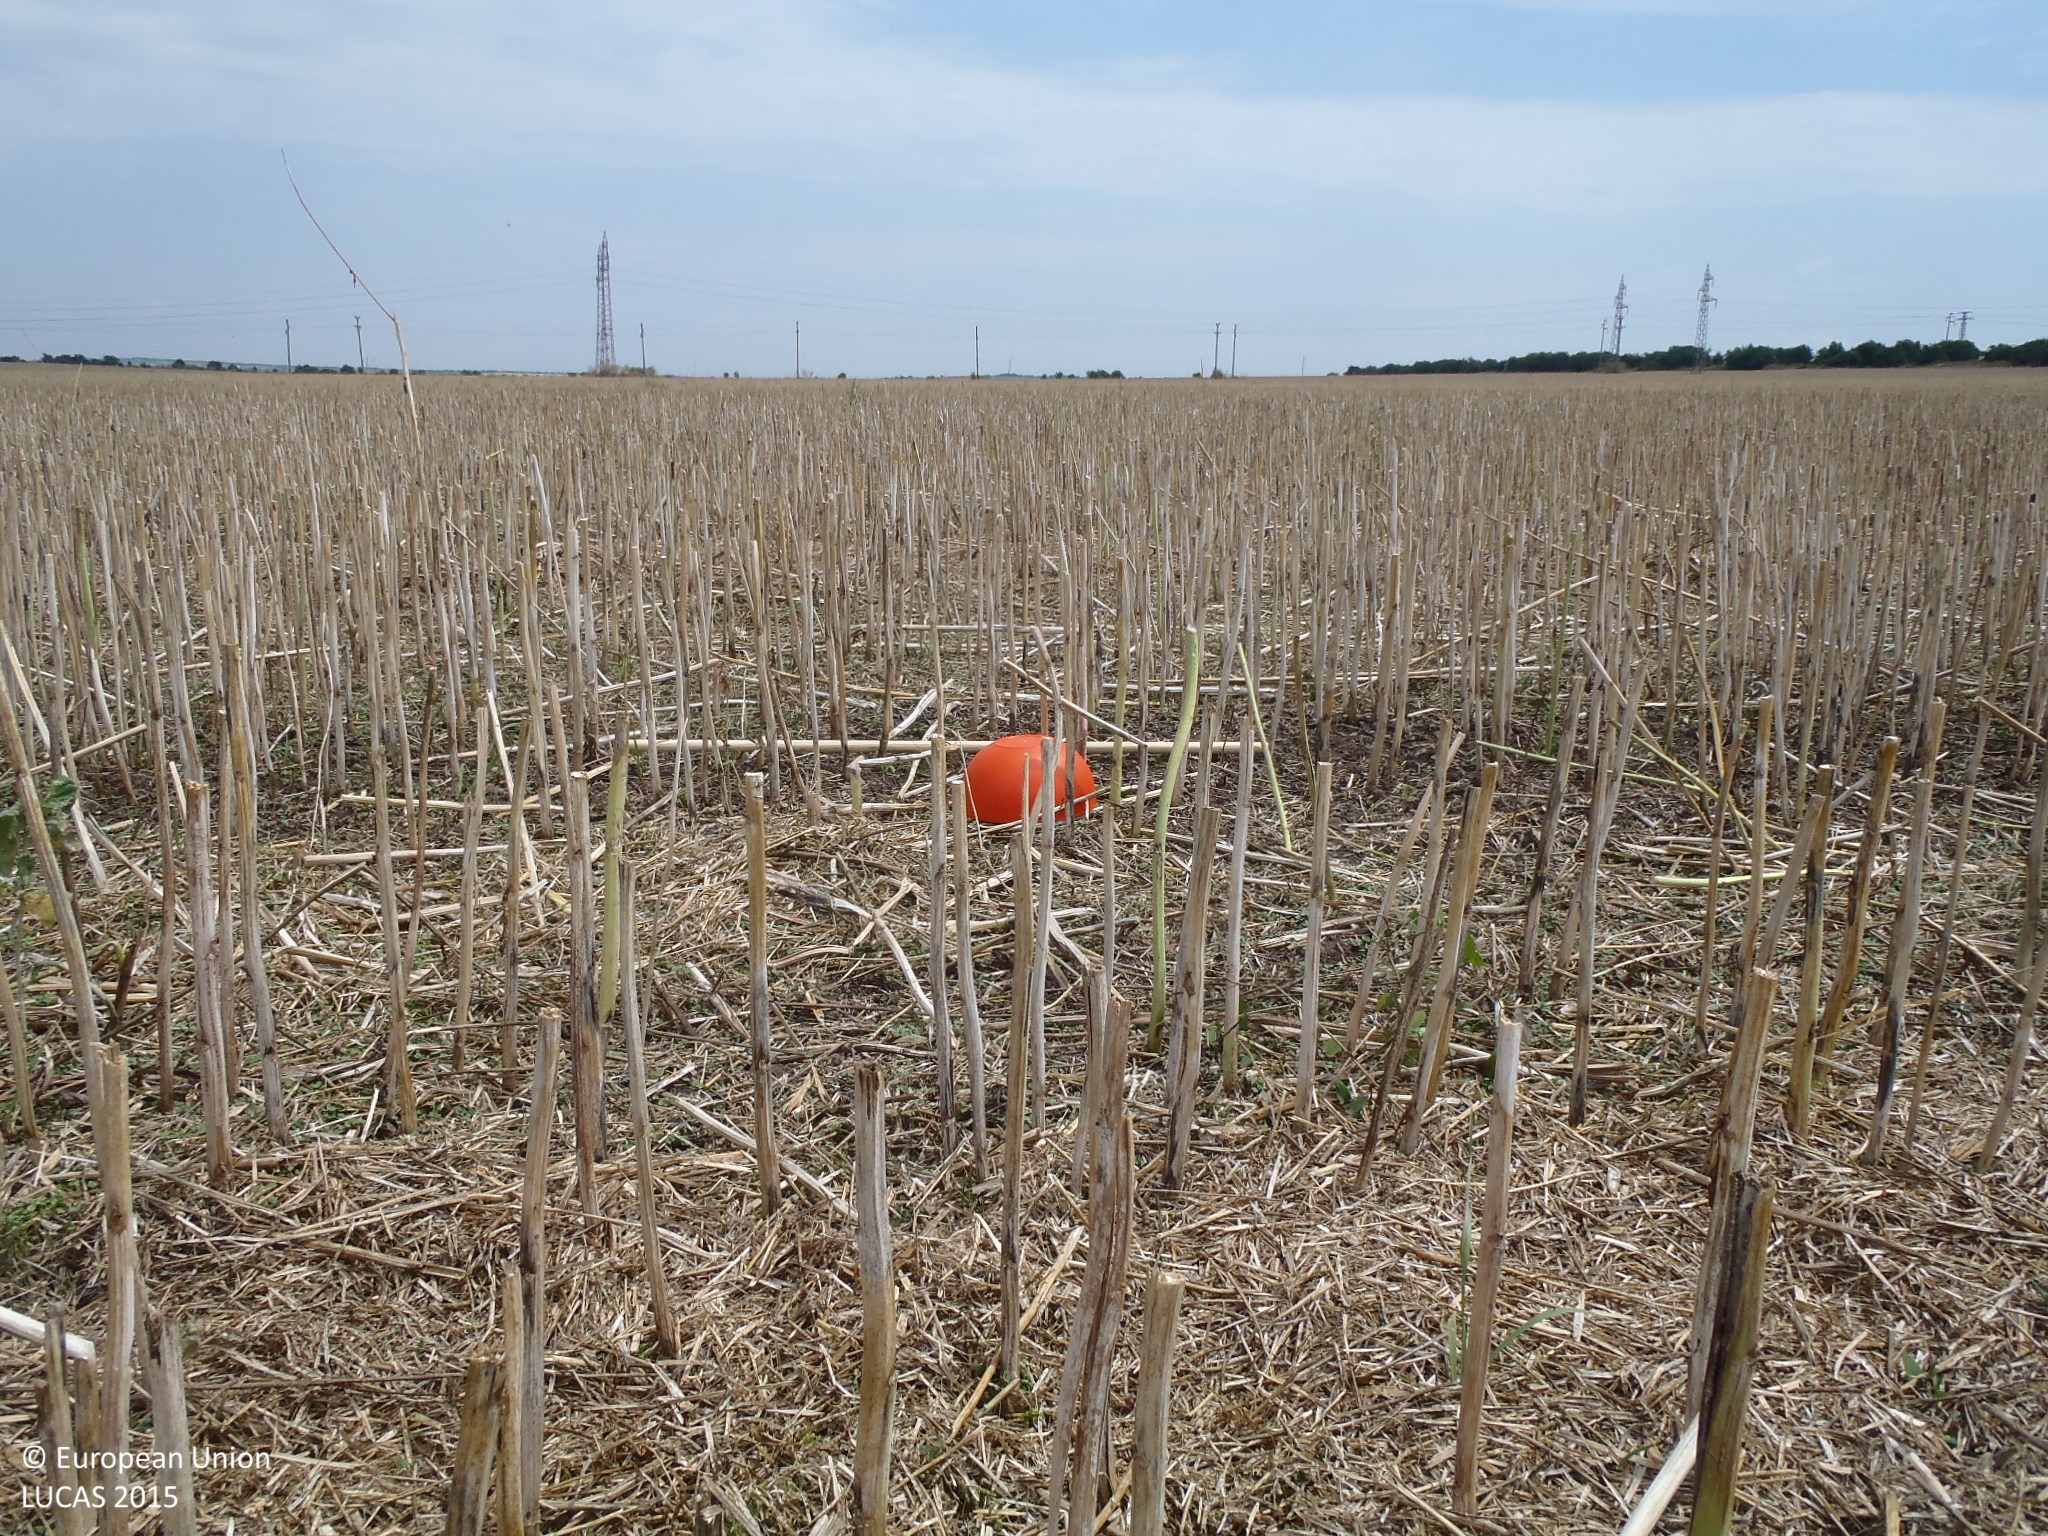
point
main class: Cropland
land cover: Rape and turnip rape
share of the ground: < 10 %
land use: Agriculture (excluding fallow land and kitchen gardens)
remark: Harvested field
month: July
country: BG
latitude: 43.9313
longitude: 26.3108
